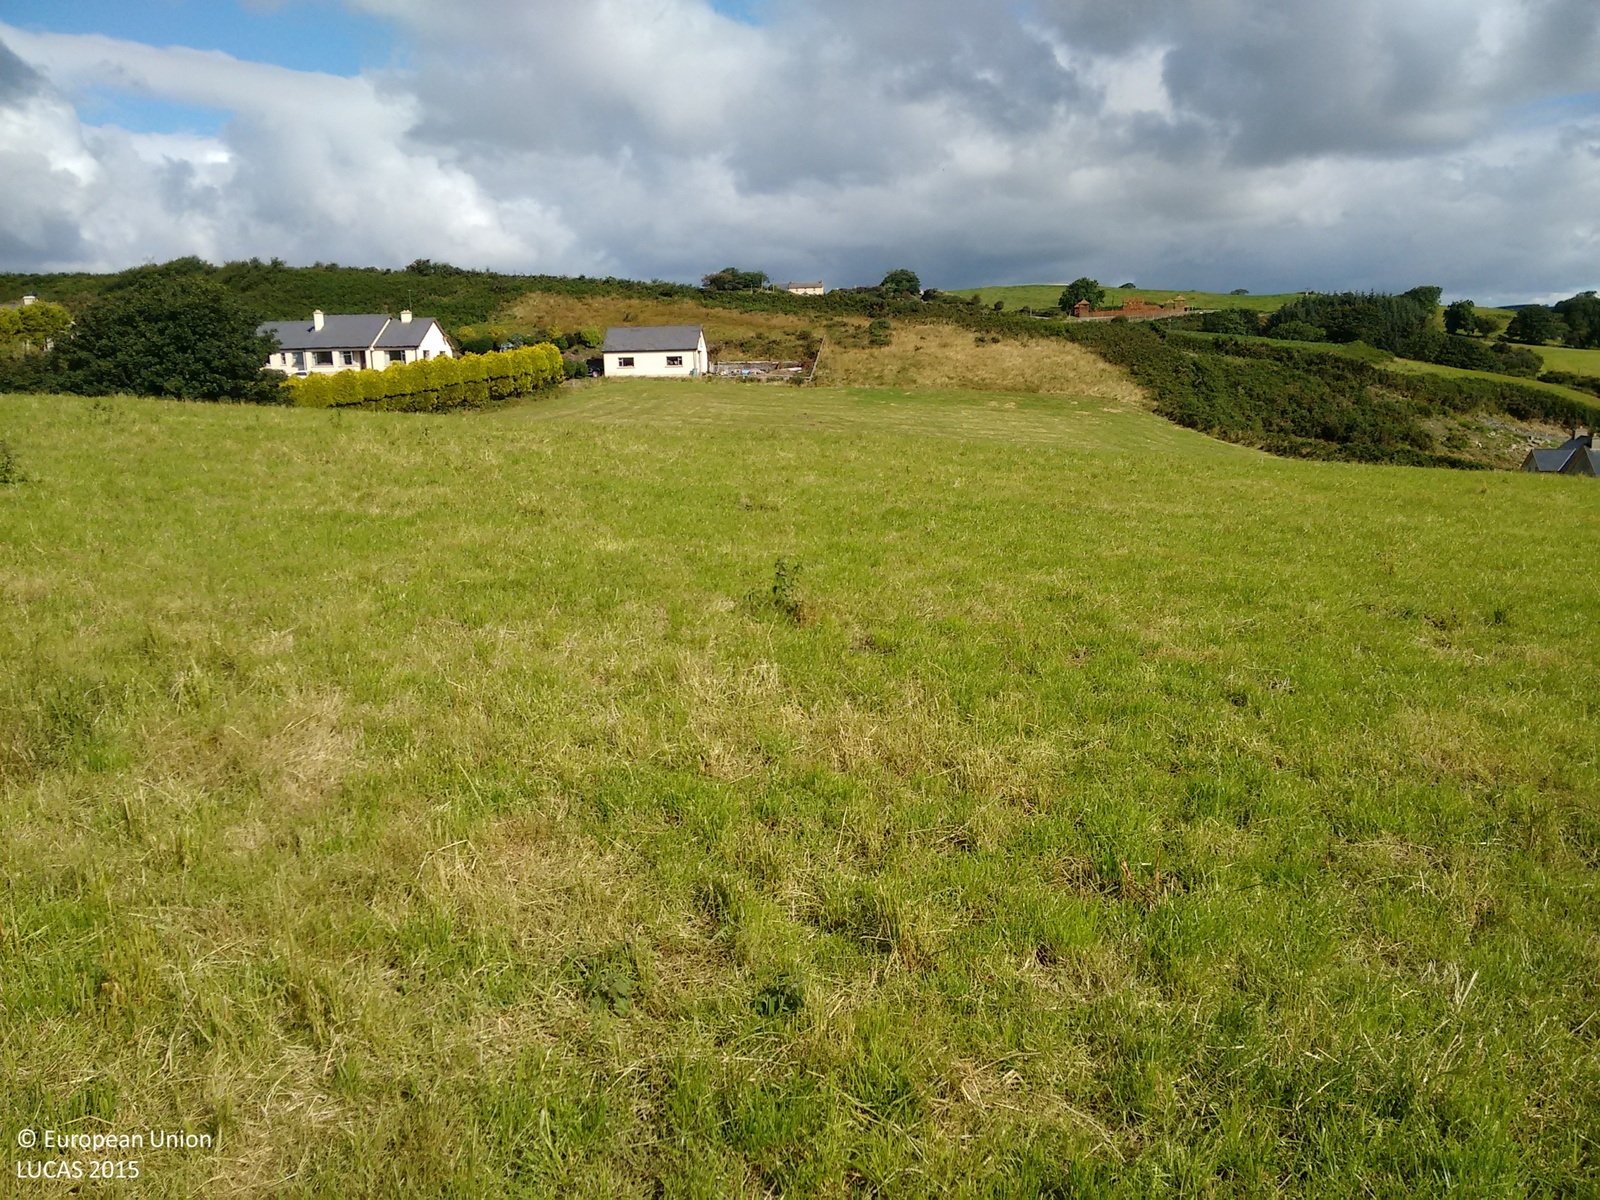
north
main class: Grassland
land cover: Grassland without tree/shrub cover
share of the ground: > 75 %
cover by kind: herbaceous plants 100 %
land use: Agriculture (excluding fallow land and kitchen gardens)
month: July
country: IE
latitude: 51.5728
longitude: -9.0437
